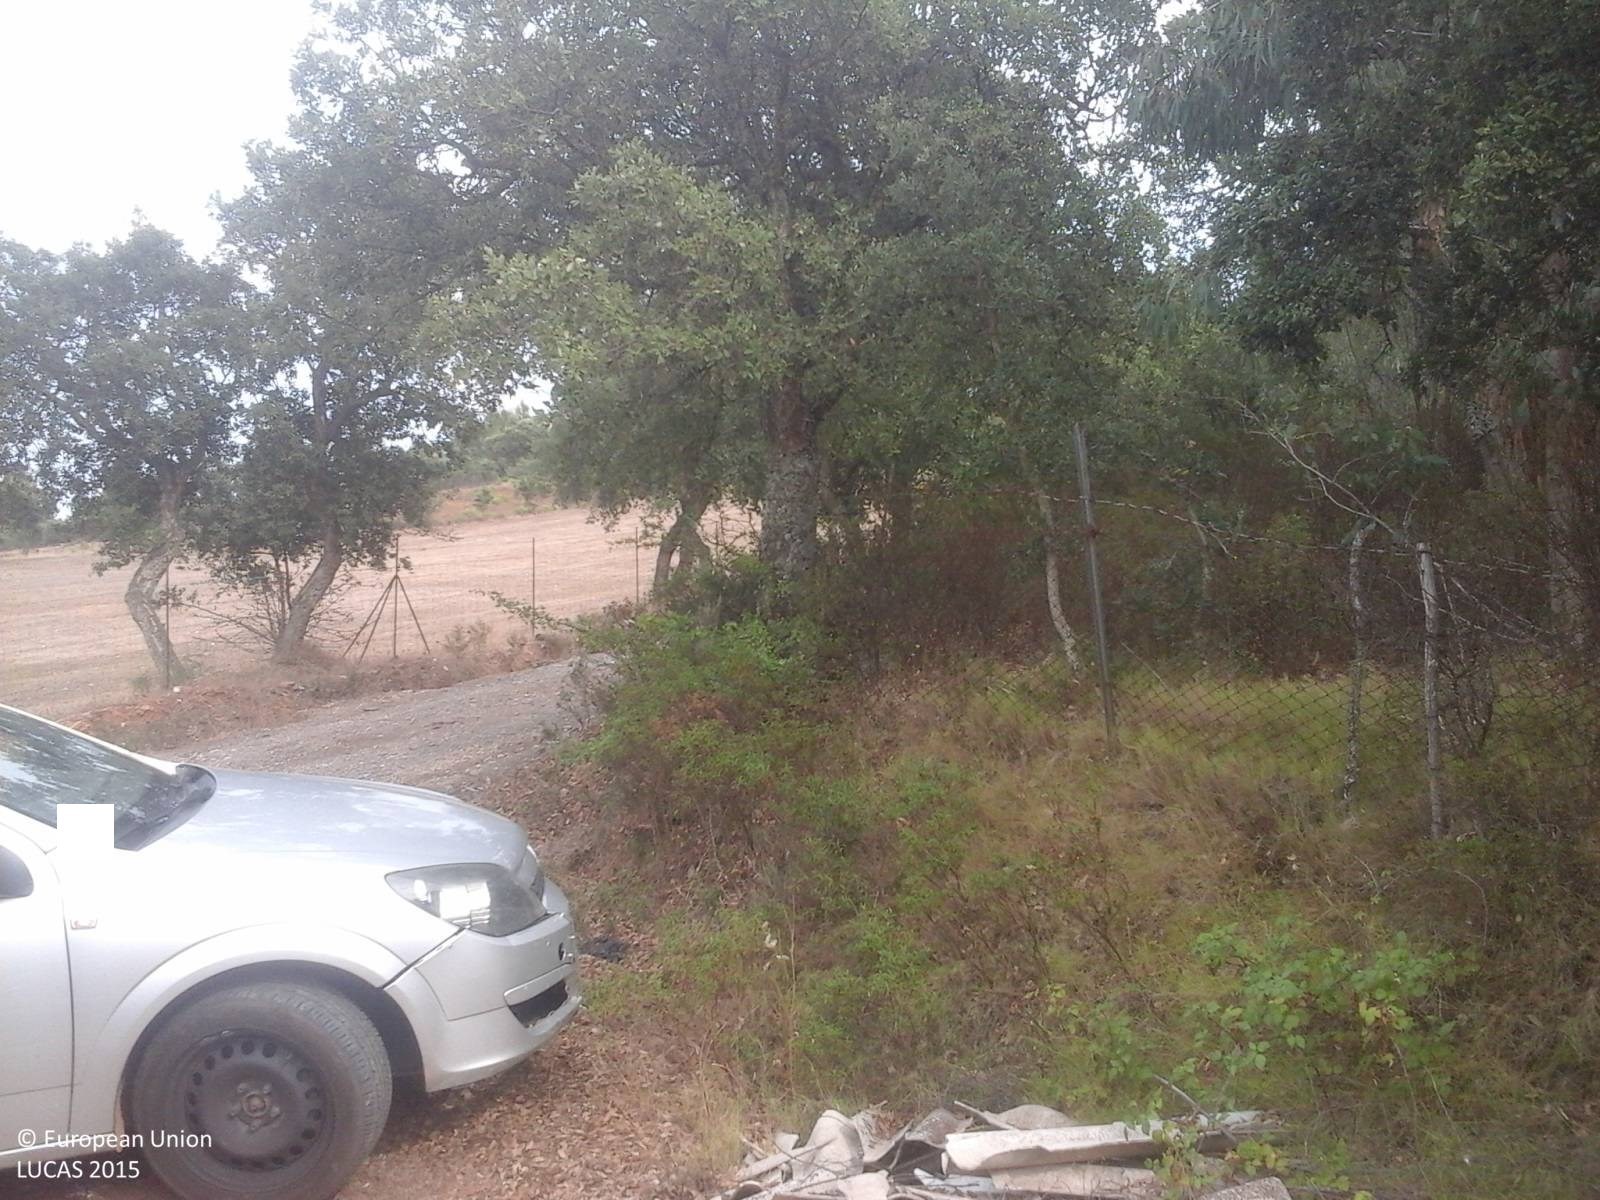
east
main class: Woodland
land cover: Broadleaved woodland
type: broadleaved evergreen forest
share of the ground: > 75 %
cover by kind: broadleaved forest trees 60 %, shrubs 20 %, unconsolidated bare surface 20 %
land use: Forestry
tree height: > 5 m
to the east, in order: Broadleaved woodland; Fences; Dry stone walls; Tracks; Fences; Temporary grasslands; Shrubland with sparse tree cover; Vineyards; Abandoned hedges; Vineyards; Abandoned hedges; Vineyards
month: August
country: IT
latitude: 39.5759
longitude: 9.2014
